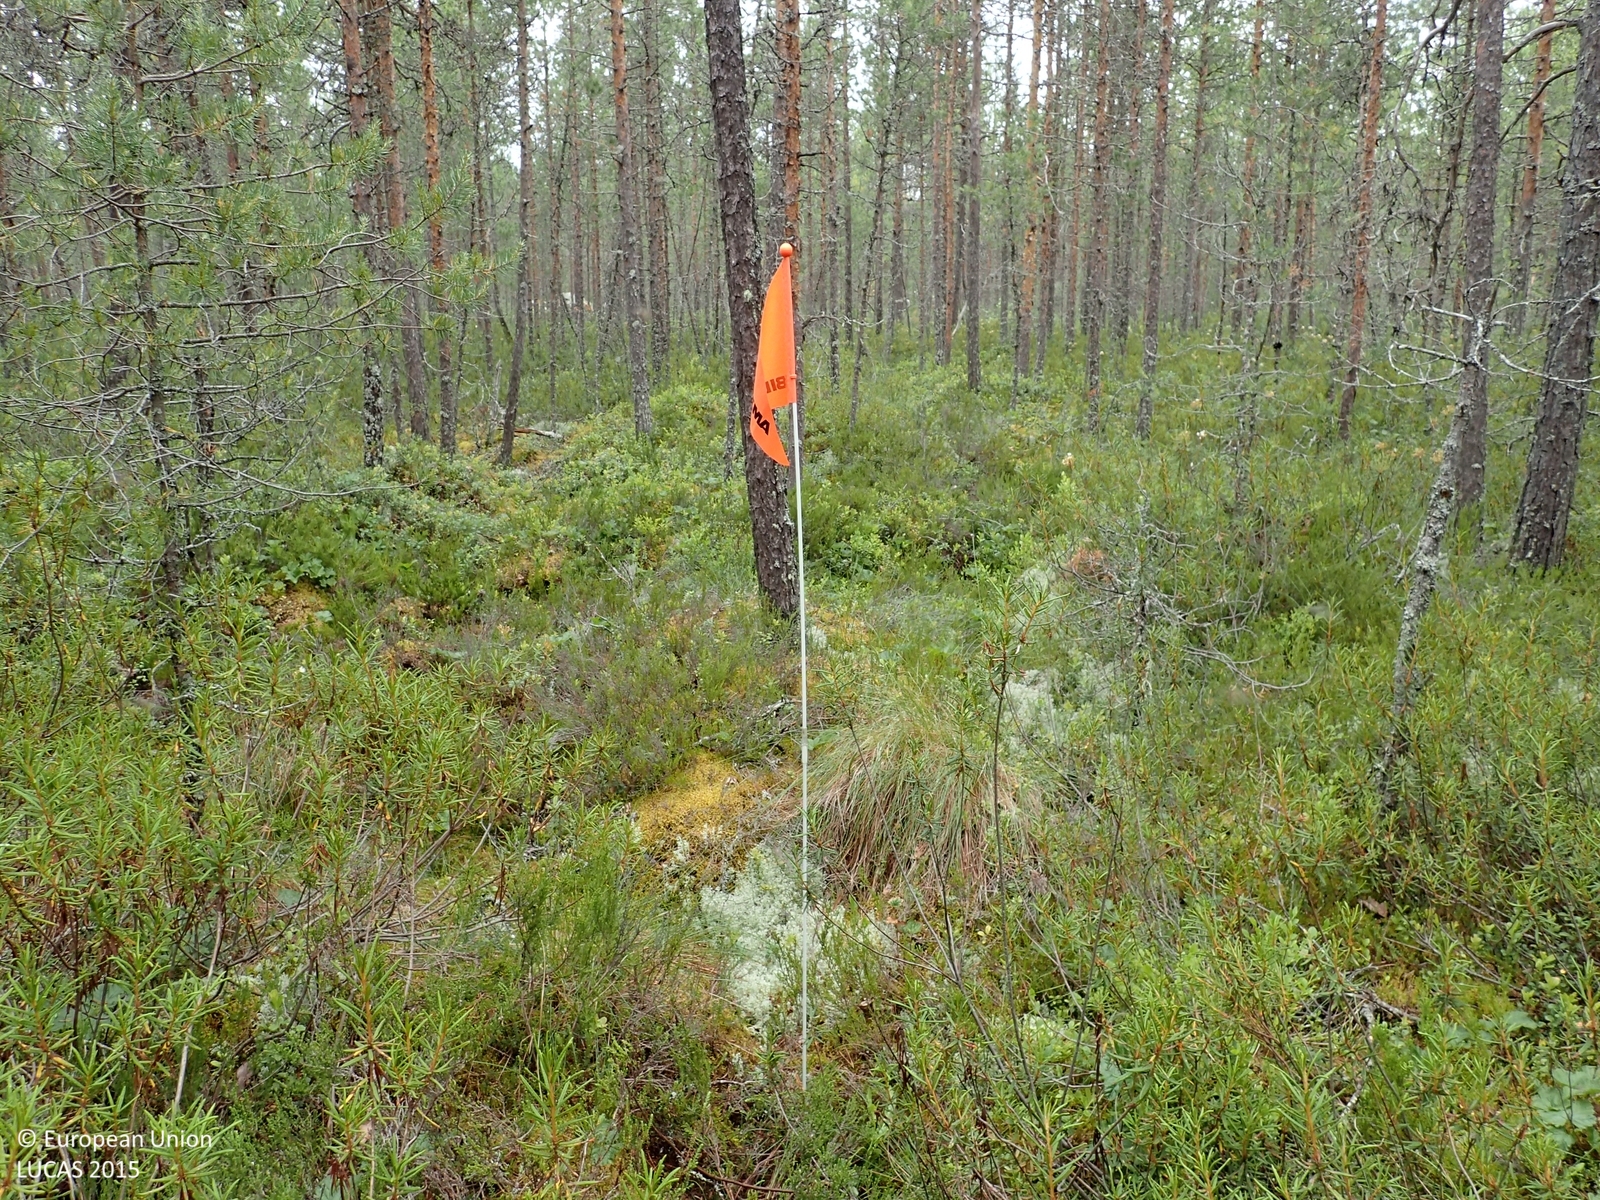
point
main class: Woodland
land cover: Pine dominated coniferous woodland
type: mire and swamp forests
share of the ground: 50 - 75 %
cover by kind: coniferous forest trees 50 %, shrubs 50 %
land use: Forestry
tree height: < 5 m
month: July
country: FI
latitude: 62.9321
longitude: 21.8031
